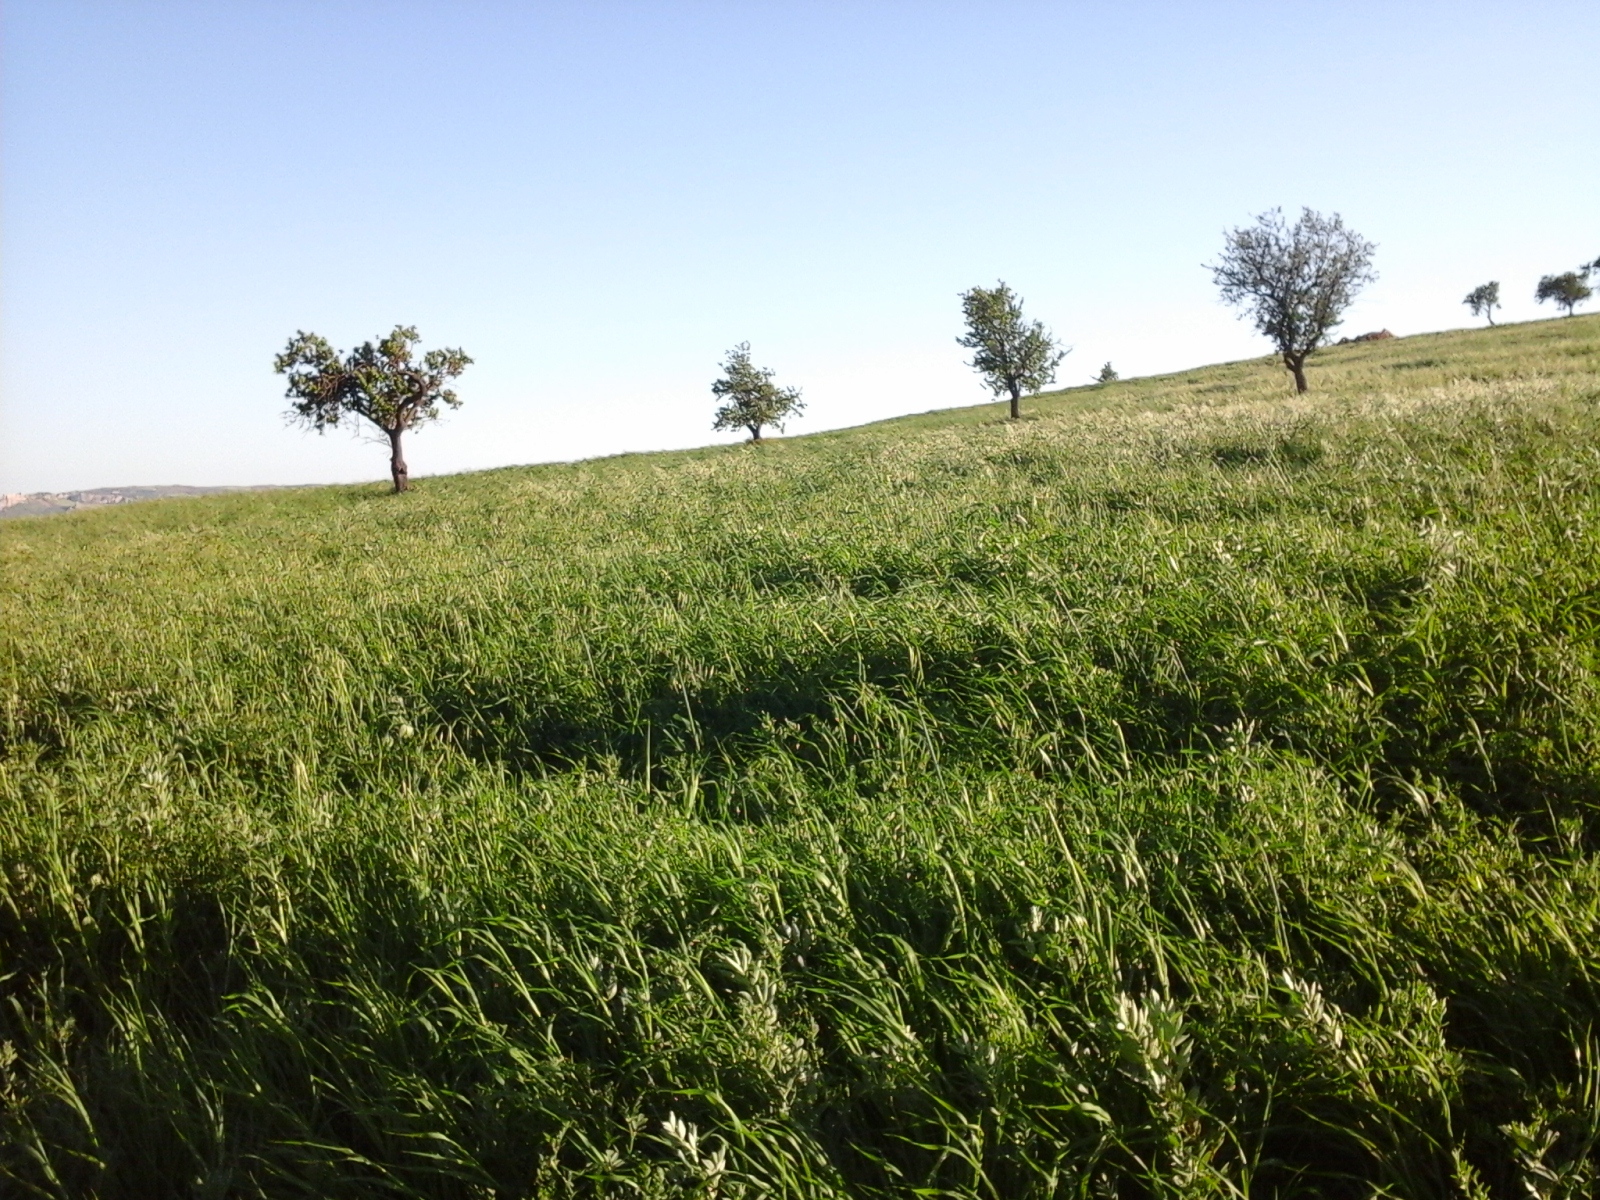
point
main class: Cropland
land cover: Dry pulses
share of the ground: > 75 %
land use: Agriculture (excluding fallow land and kitchen gardens)
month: May
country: IT
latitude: 37.4947
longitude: 14.1203
